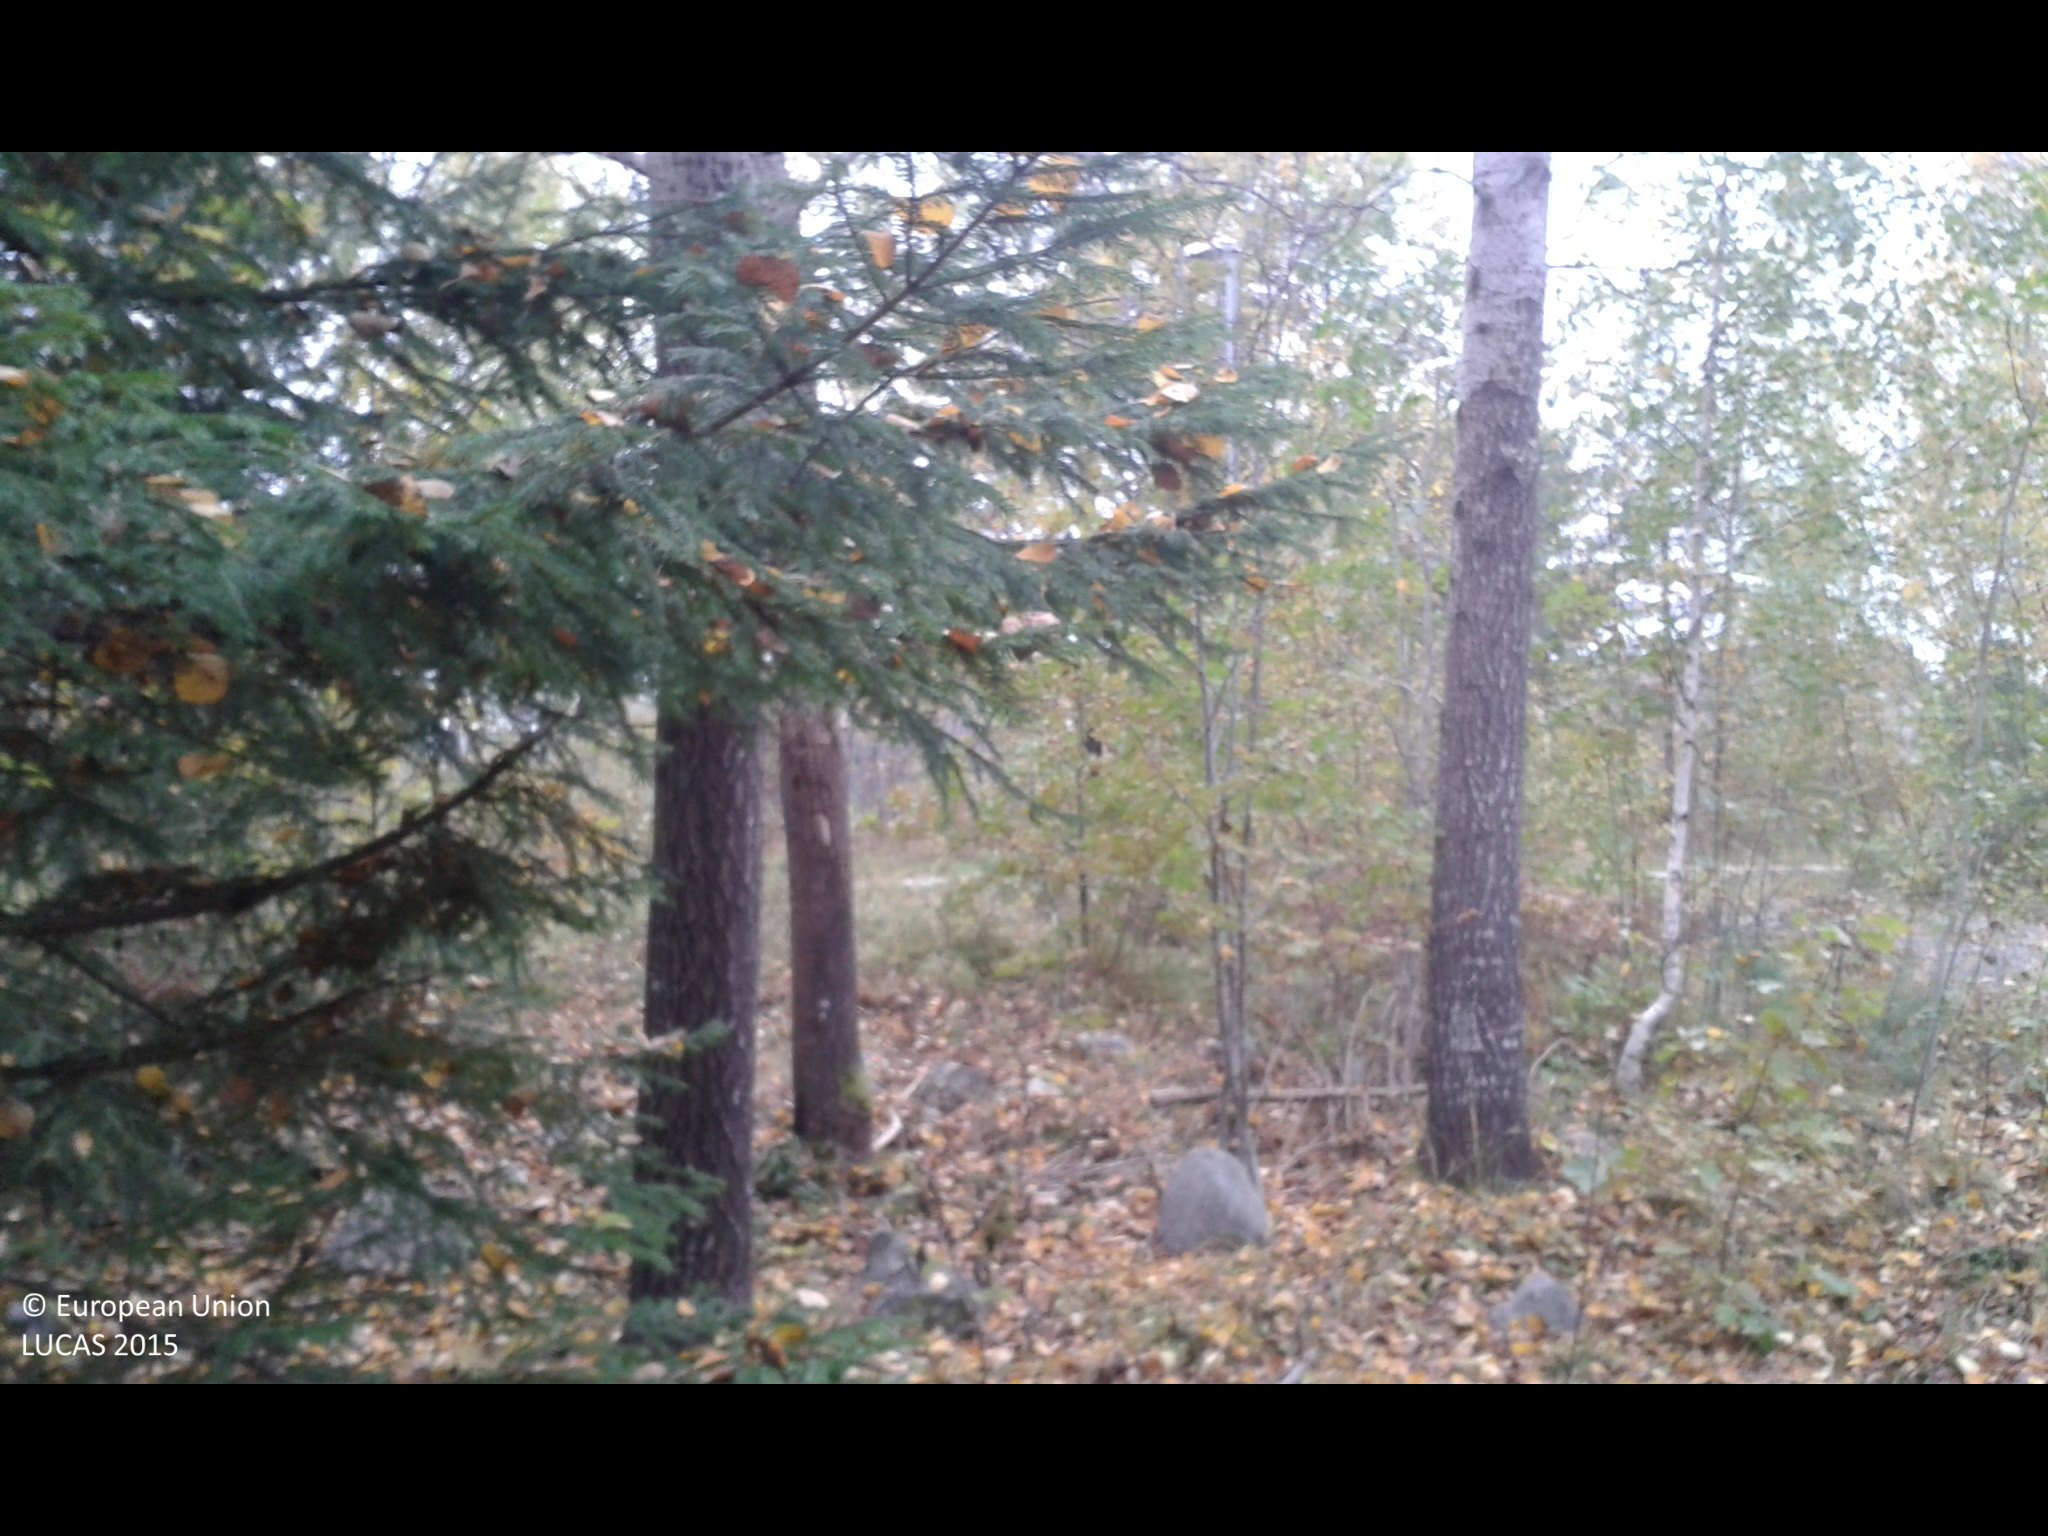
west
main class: Woodland
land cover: Broadleaved woodland
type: hemiboreal forest and nemoral coniferous forest and mixed broadleaved-coniferous forest
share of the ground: 50 - 75 %
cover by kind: broadleaved forest trees 60 %, herbaceous plants 30 %, coniferous forest trees 10 %
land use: Telecommunication
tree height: > 5 m
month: October
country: SE
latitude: 58.7223
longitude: 17.0252
